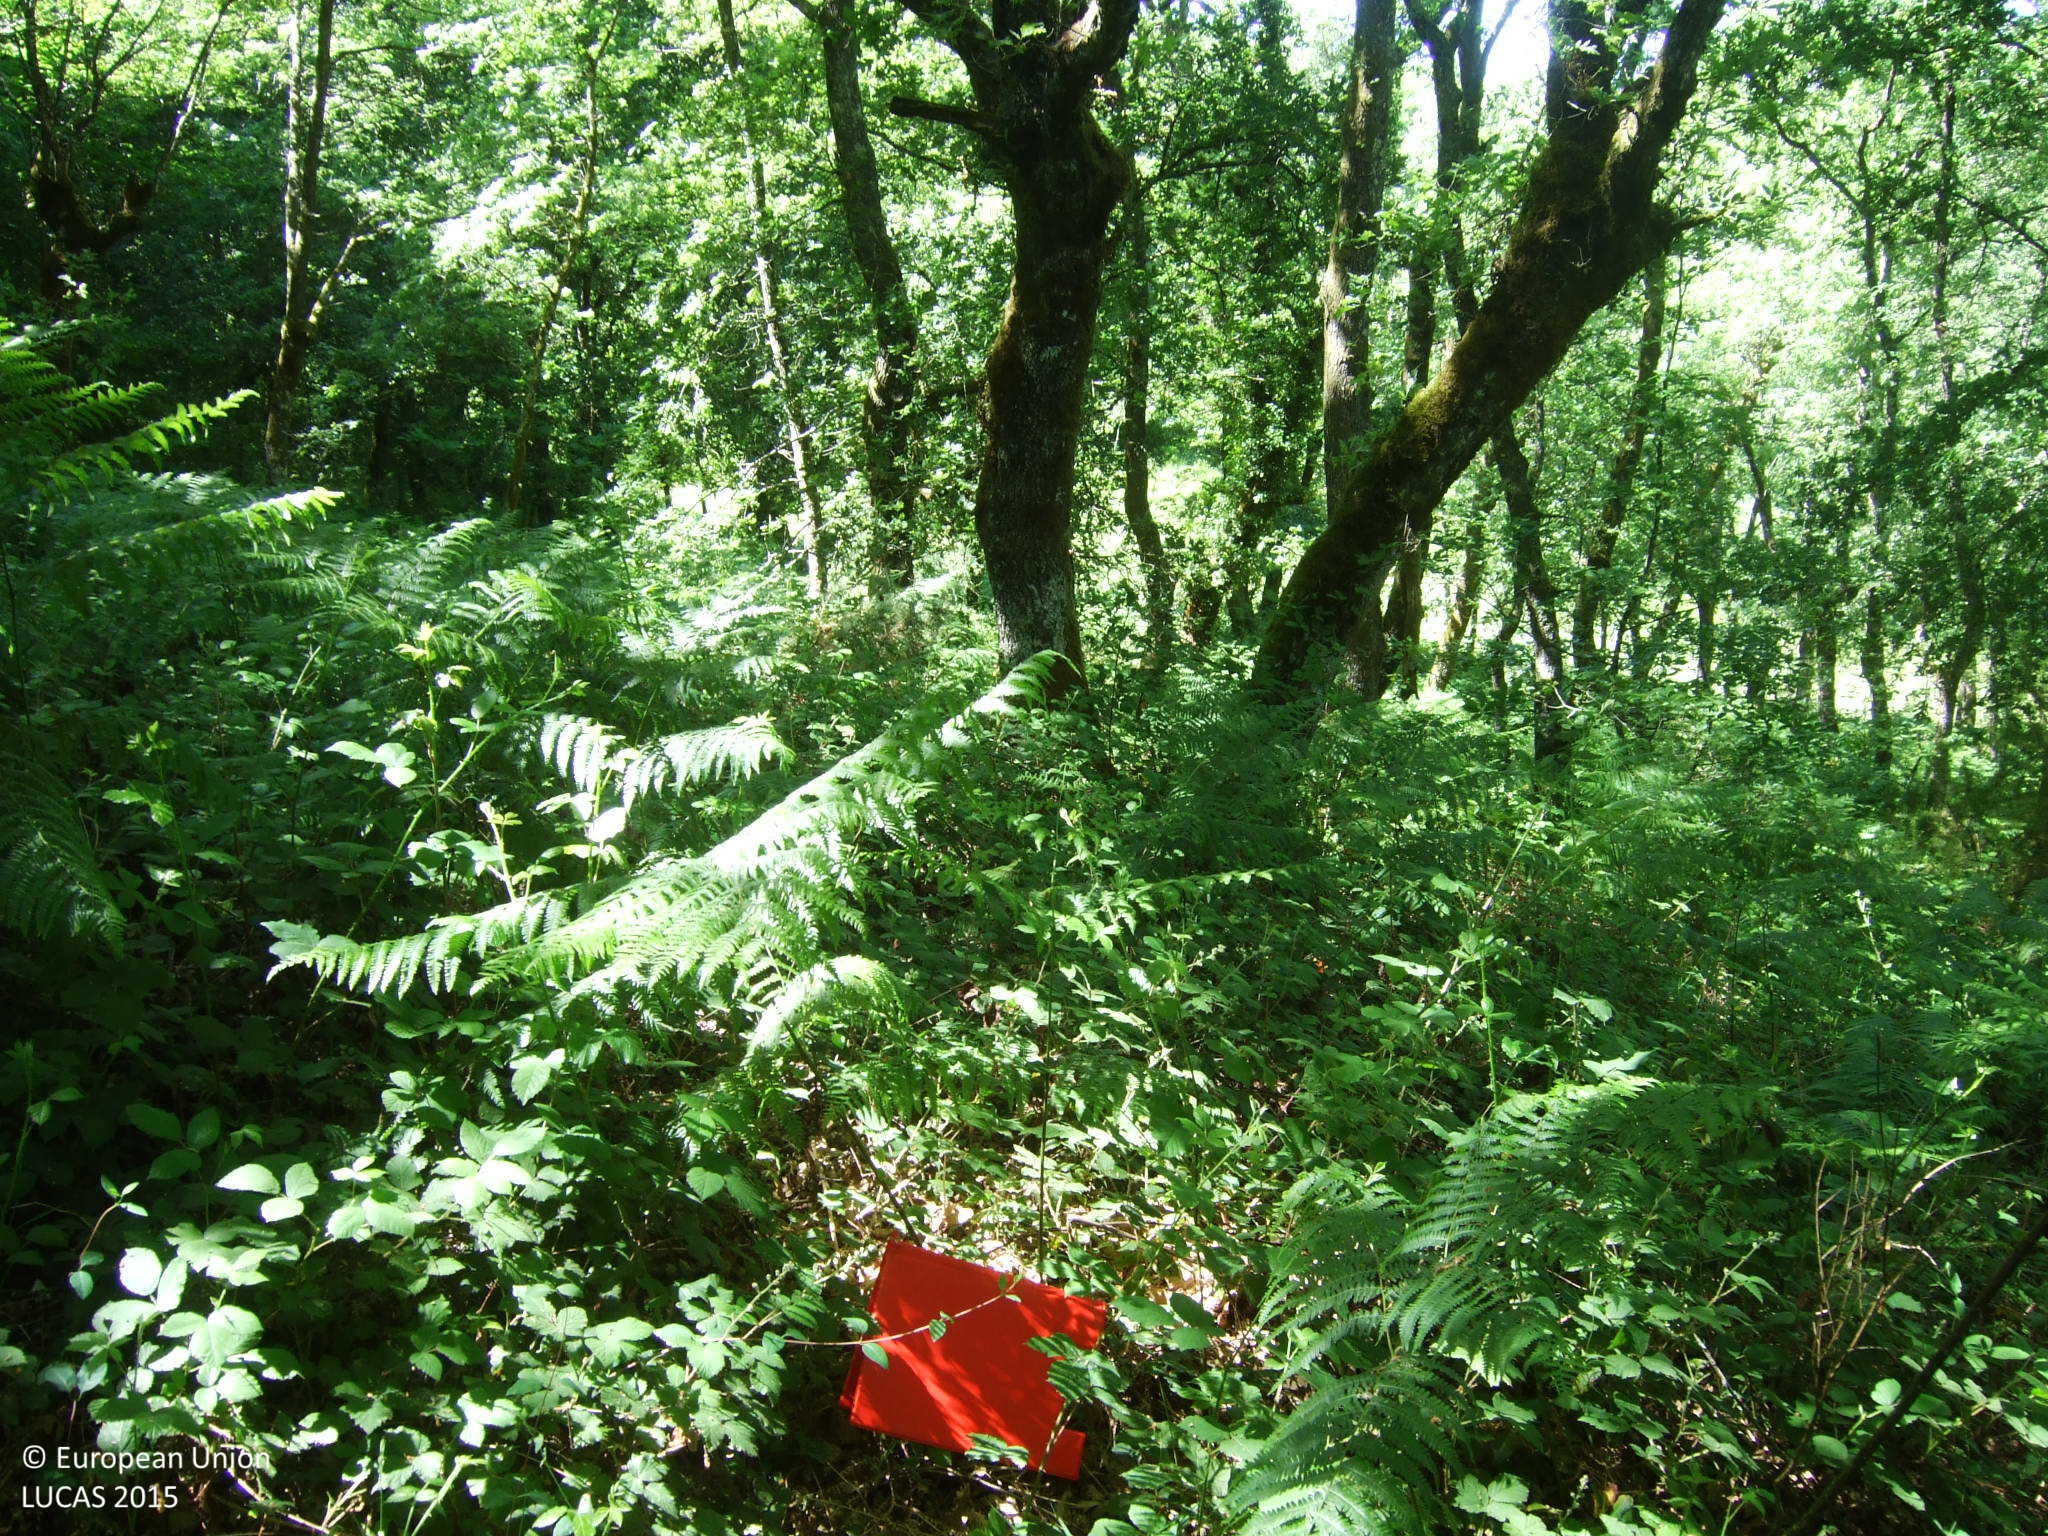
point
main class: Woodland
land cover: Broadleaved woodland
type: acidophilous oak and oak-birch forest
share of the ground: > 75 %
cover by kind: broadleaved forest trees 80 %, shrubs 20 %
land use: Forestry
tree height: > 5 m
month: May
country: ES
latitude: 42.7031
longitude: -7.4925
